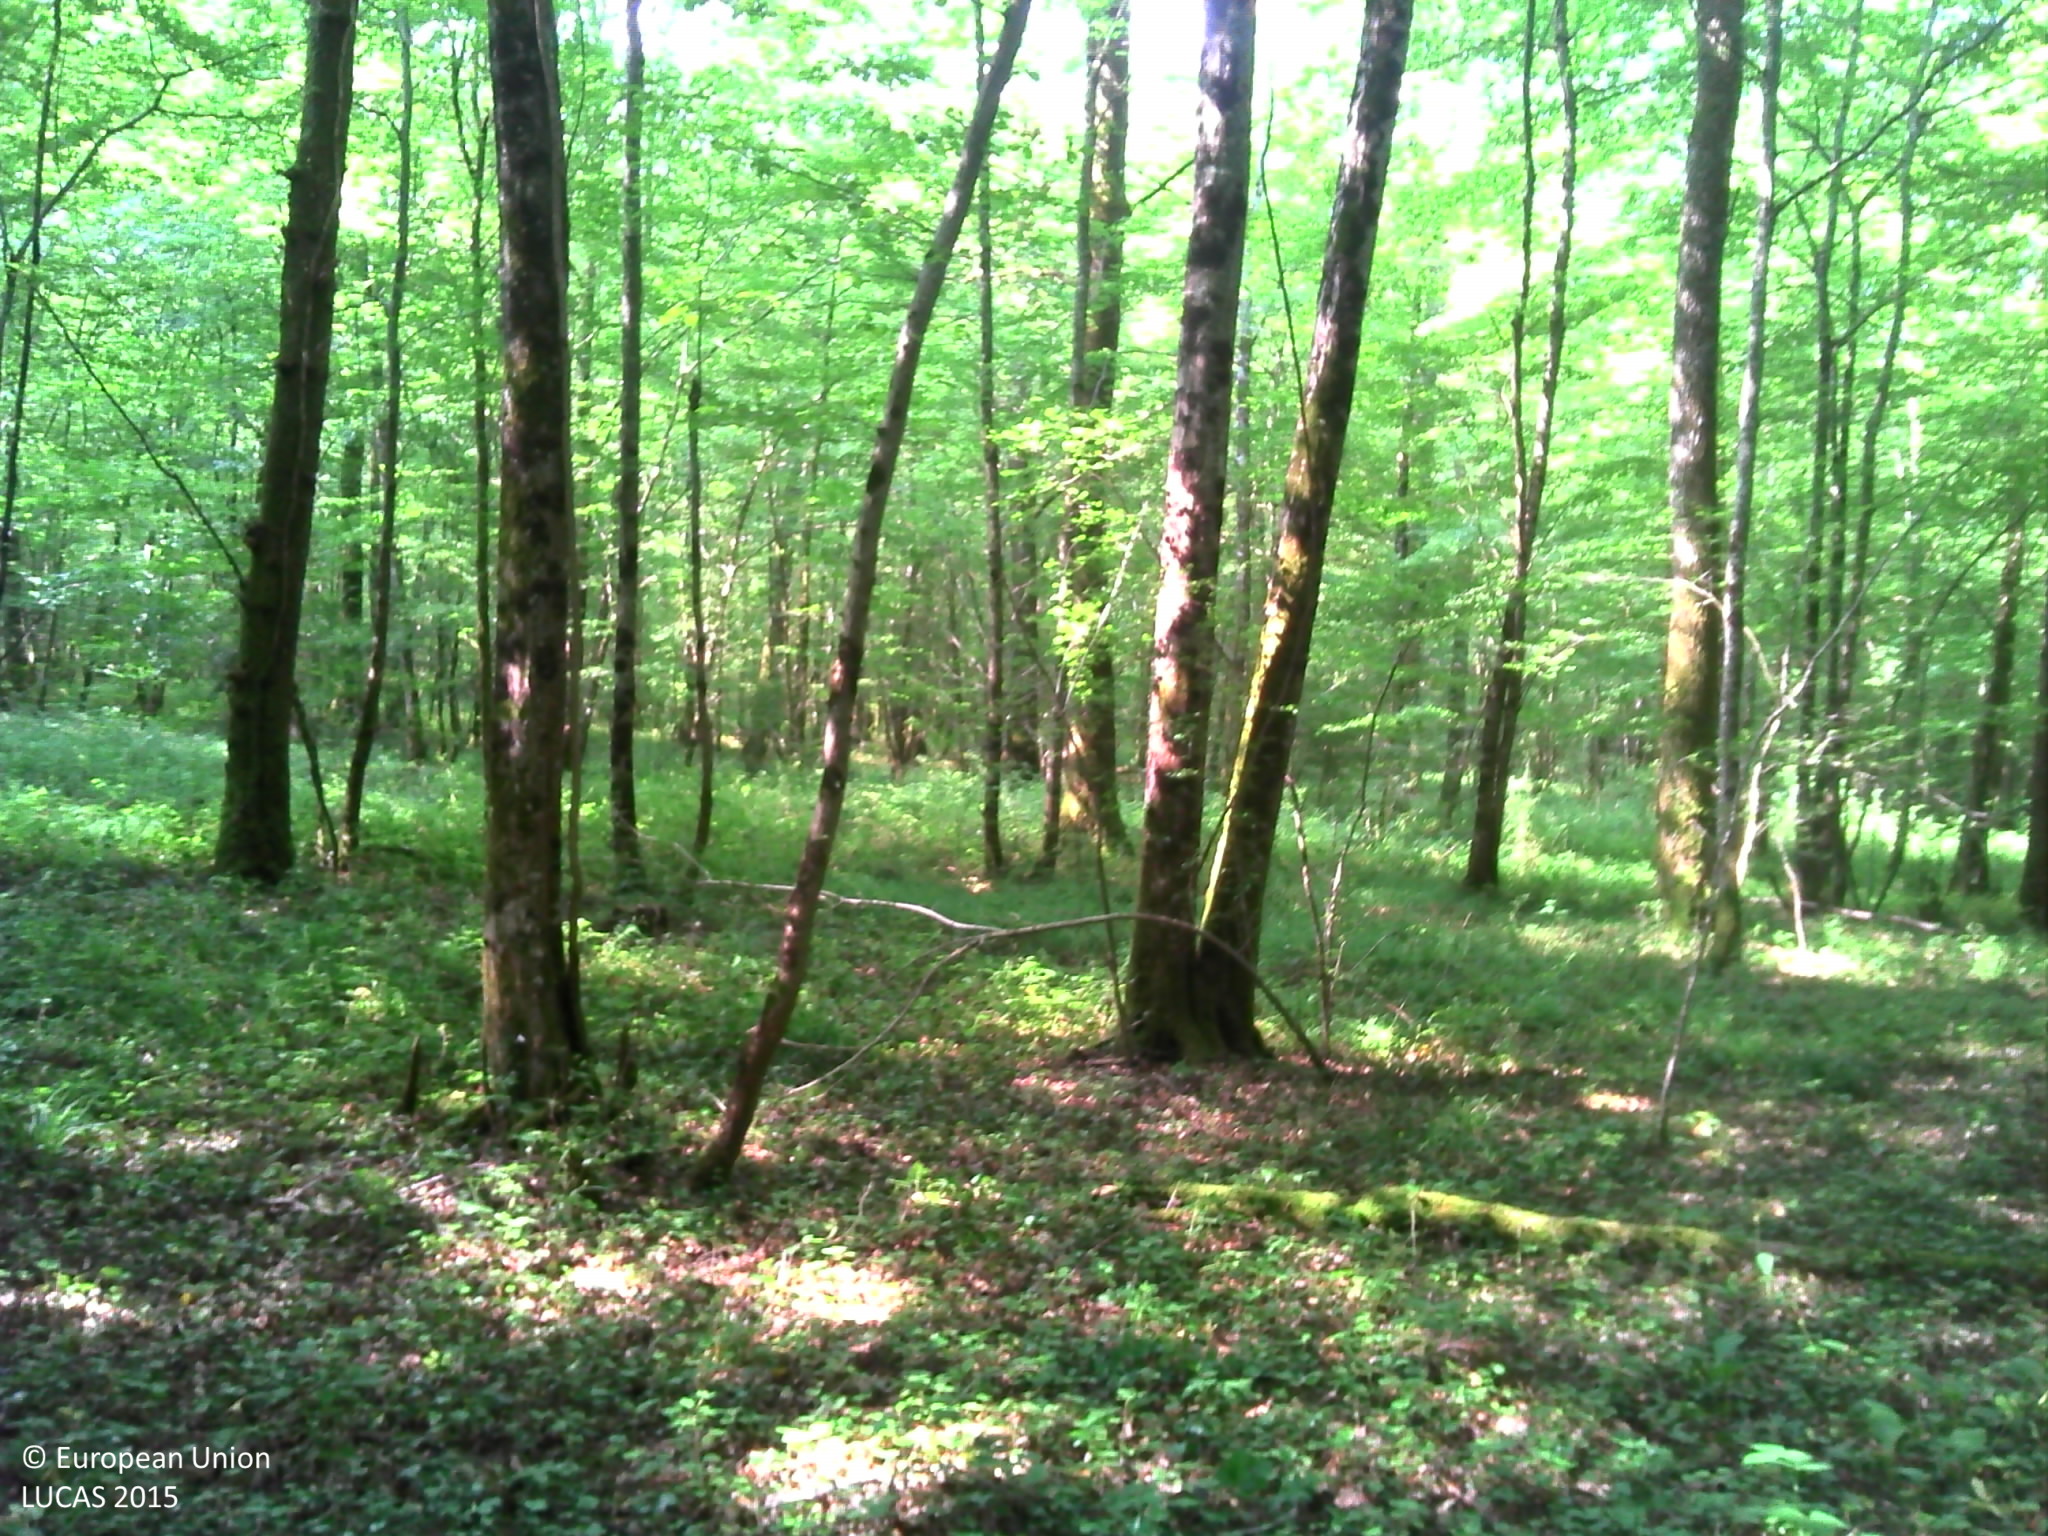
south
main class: Woodland
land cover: Broadleaved woodland
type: beech forest
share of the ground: > 75 %
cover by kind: broadleaved forest trees 95 %, herbaceous plants 5 %
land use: Forestry
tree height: > 5 m
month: June
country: FR
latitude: 47.8676
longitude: 6.1374
